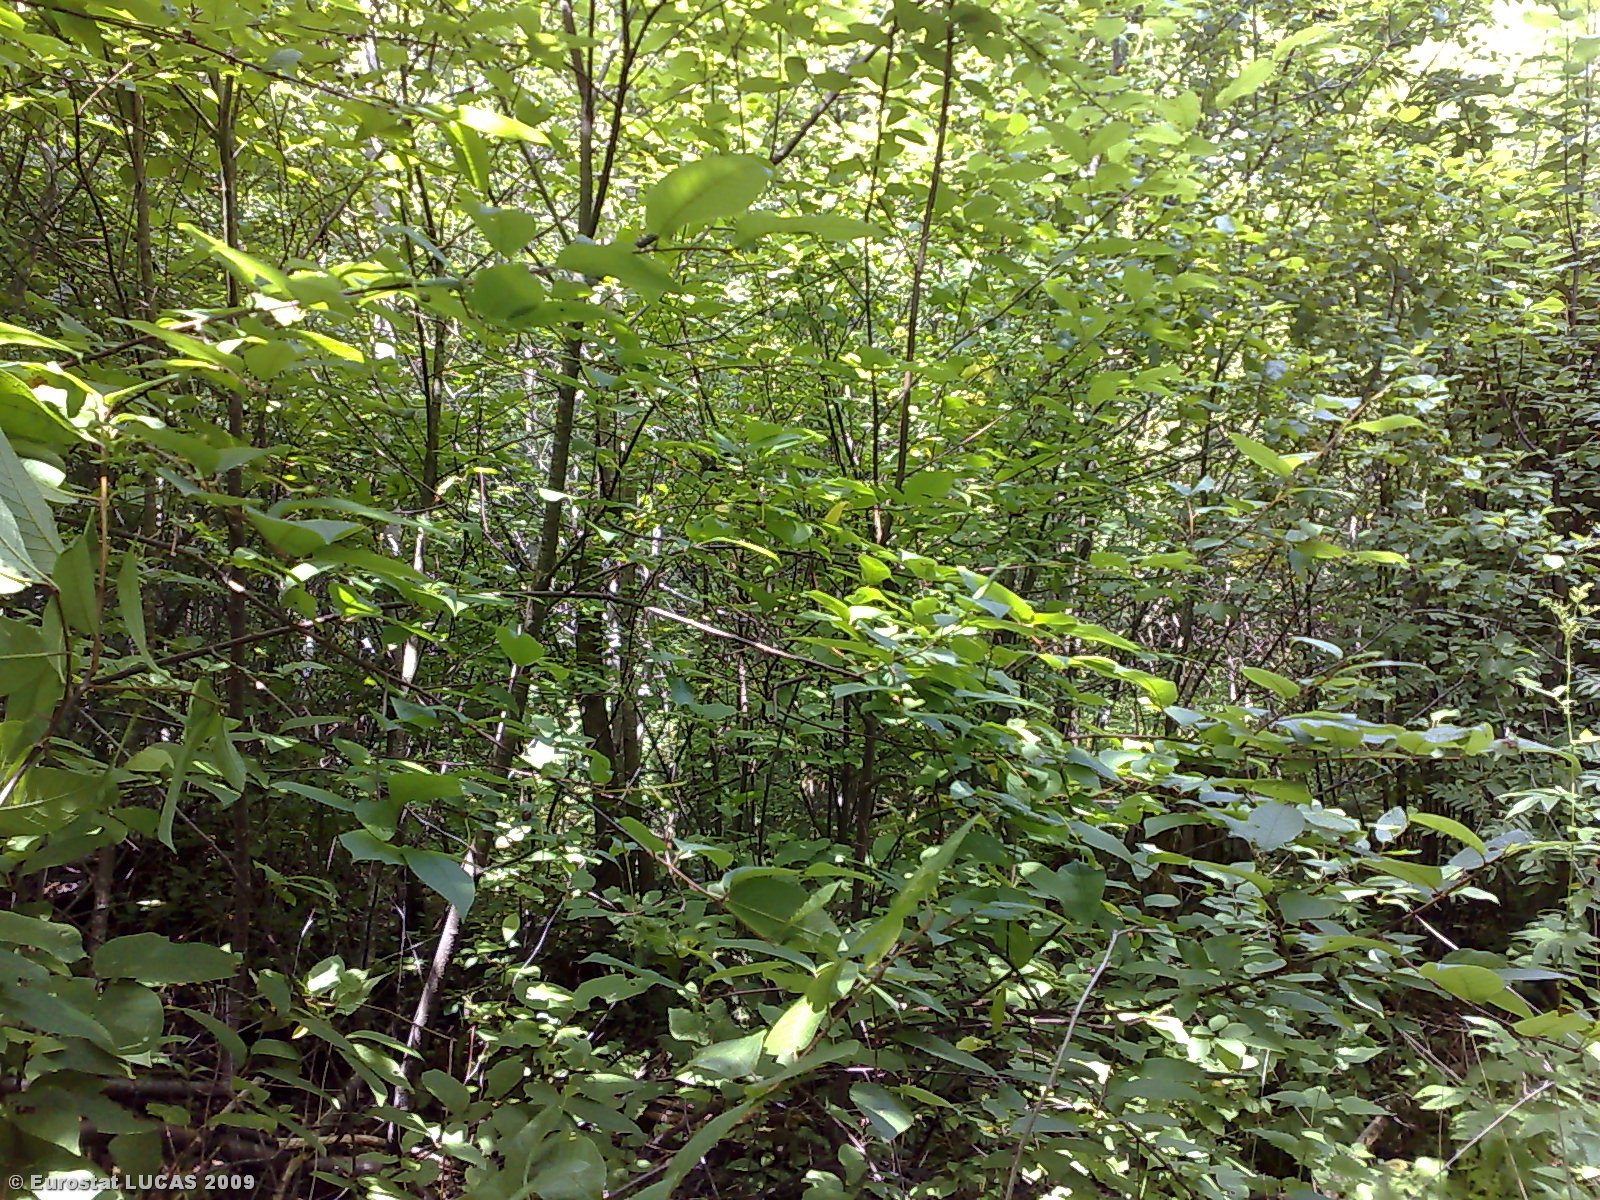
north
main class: Woodland
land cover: Broadleaved woodland
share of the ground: > 75 %
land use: Forestry
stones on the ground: < 10 %
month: July
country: LT
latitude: 55.9883
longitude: 22.9062
